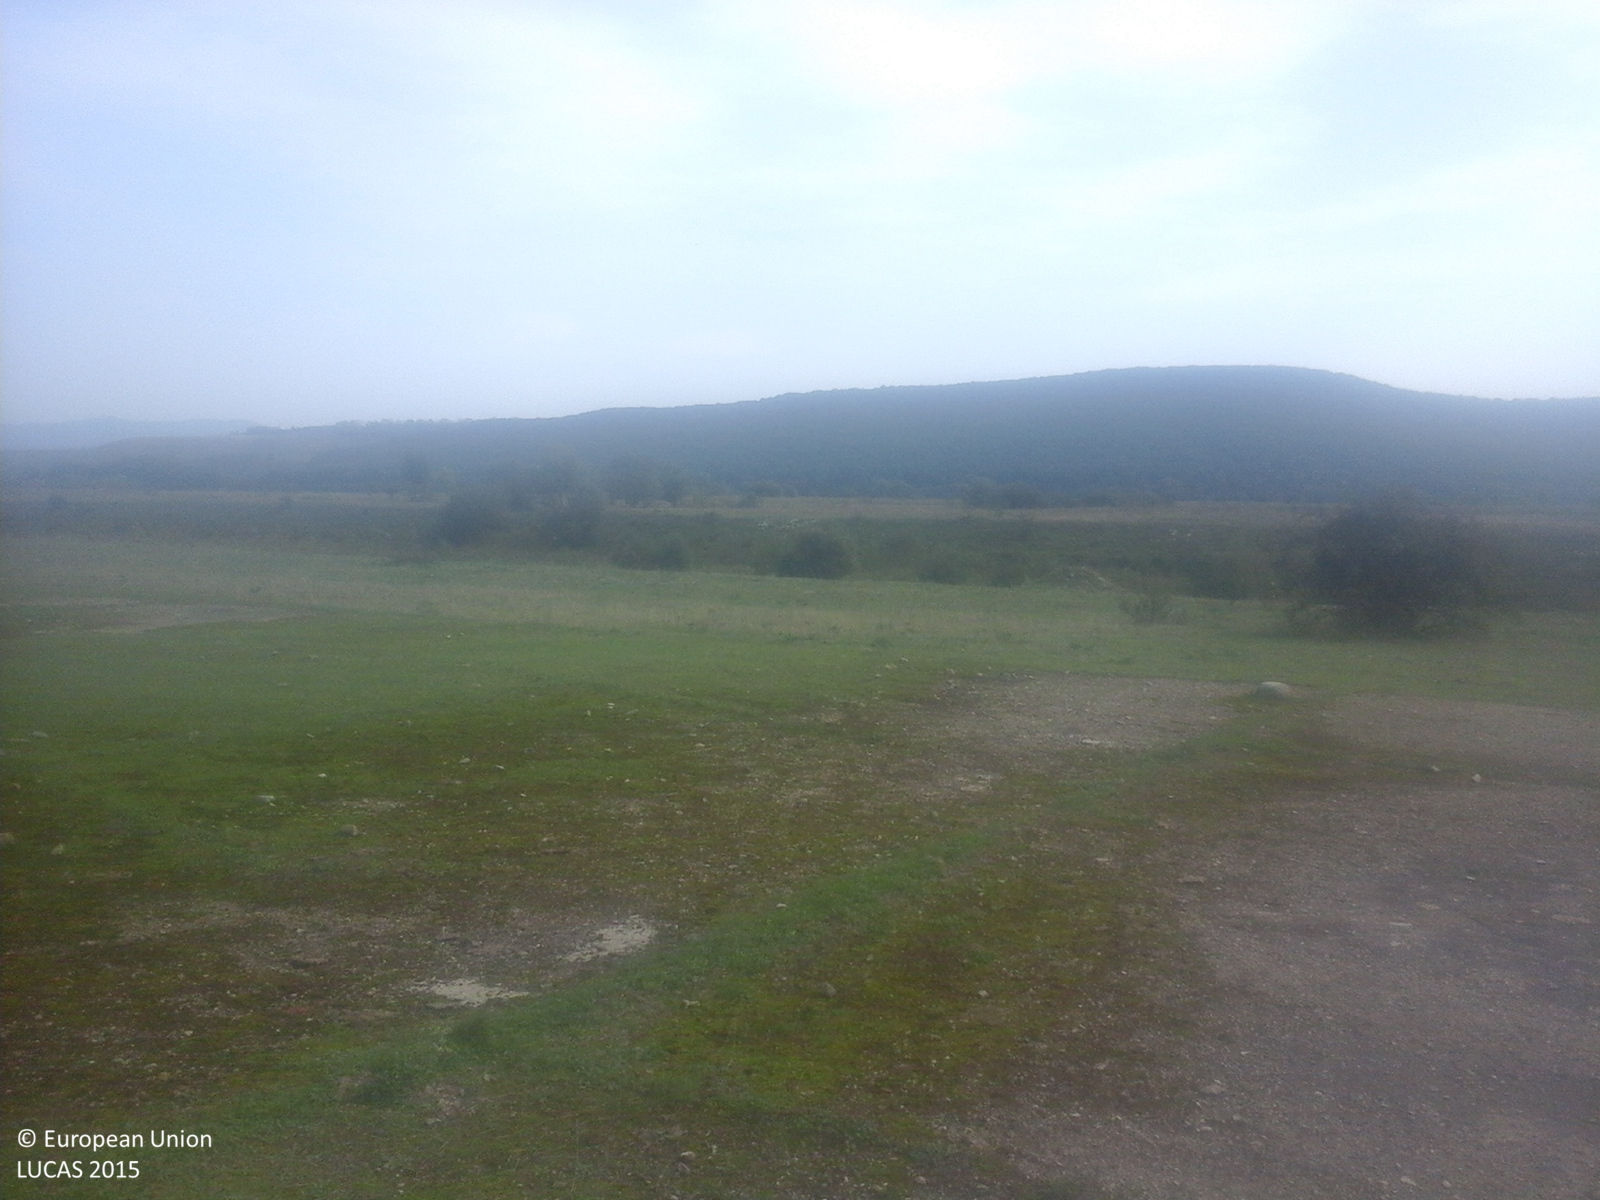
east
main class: Grassland
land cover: Grassland without tree/shrub cover
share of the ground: > 75 %
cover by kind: herbaceous plants 100 %
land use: Agriculture (excluding fallow land and kitchen gardens)
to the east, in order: Grassland without tree/shrub cover; Grassland with sparse tree/shrub cover; Inland fresh running water; Grassland with sparse tree/shrub cover; Tracks; Common wheat; Ditches and canals; Grassland without tree/shrub cover
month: September
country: RO
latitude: 45.5336
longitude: 22.8691
